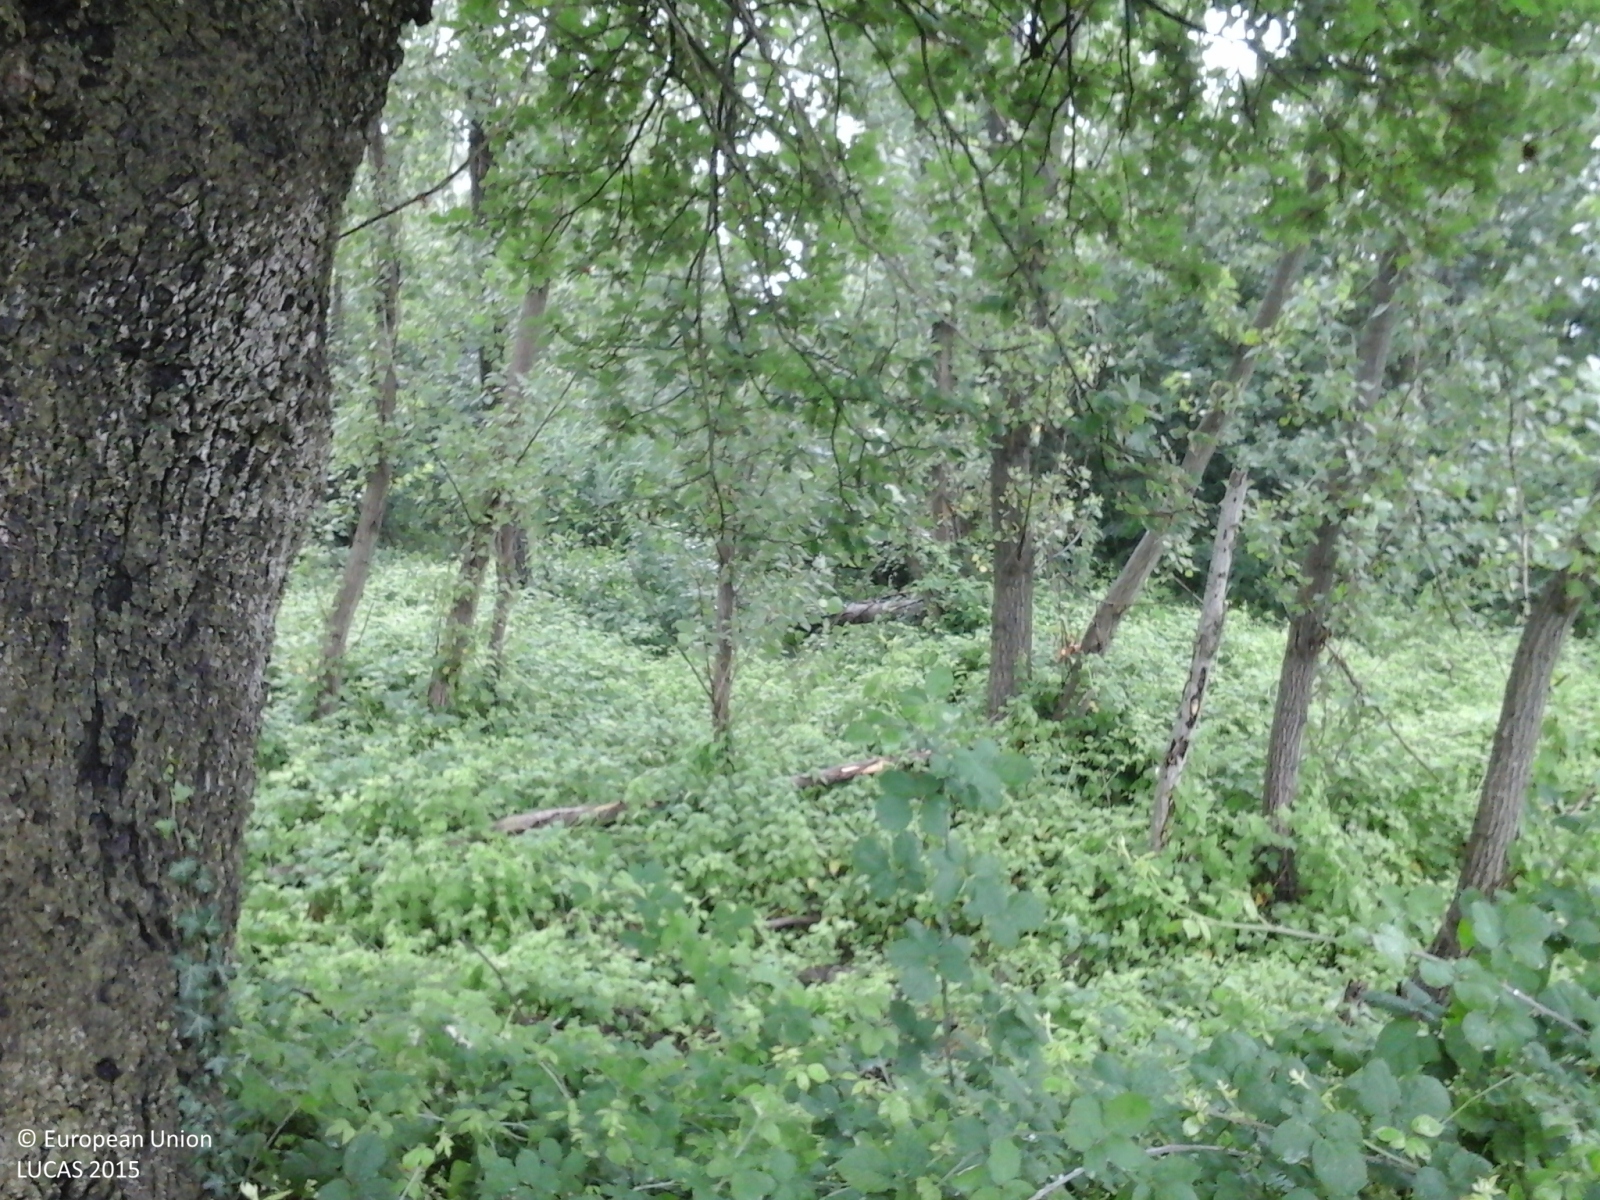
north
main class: Woodland
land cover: Broadleaved woodland
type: thermophilous deciduous forest
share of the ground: > 75 %
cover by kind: broadleaved forest trees 90 %, shrubs 10 %
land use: Forestry
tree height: > 5 m
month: June
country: IT
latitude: 44.3285
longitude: 10.9133
